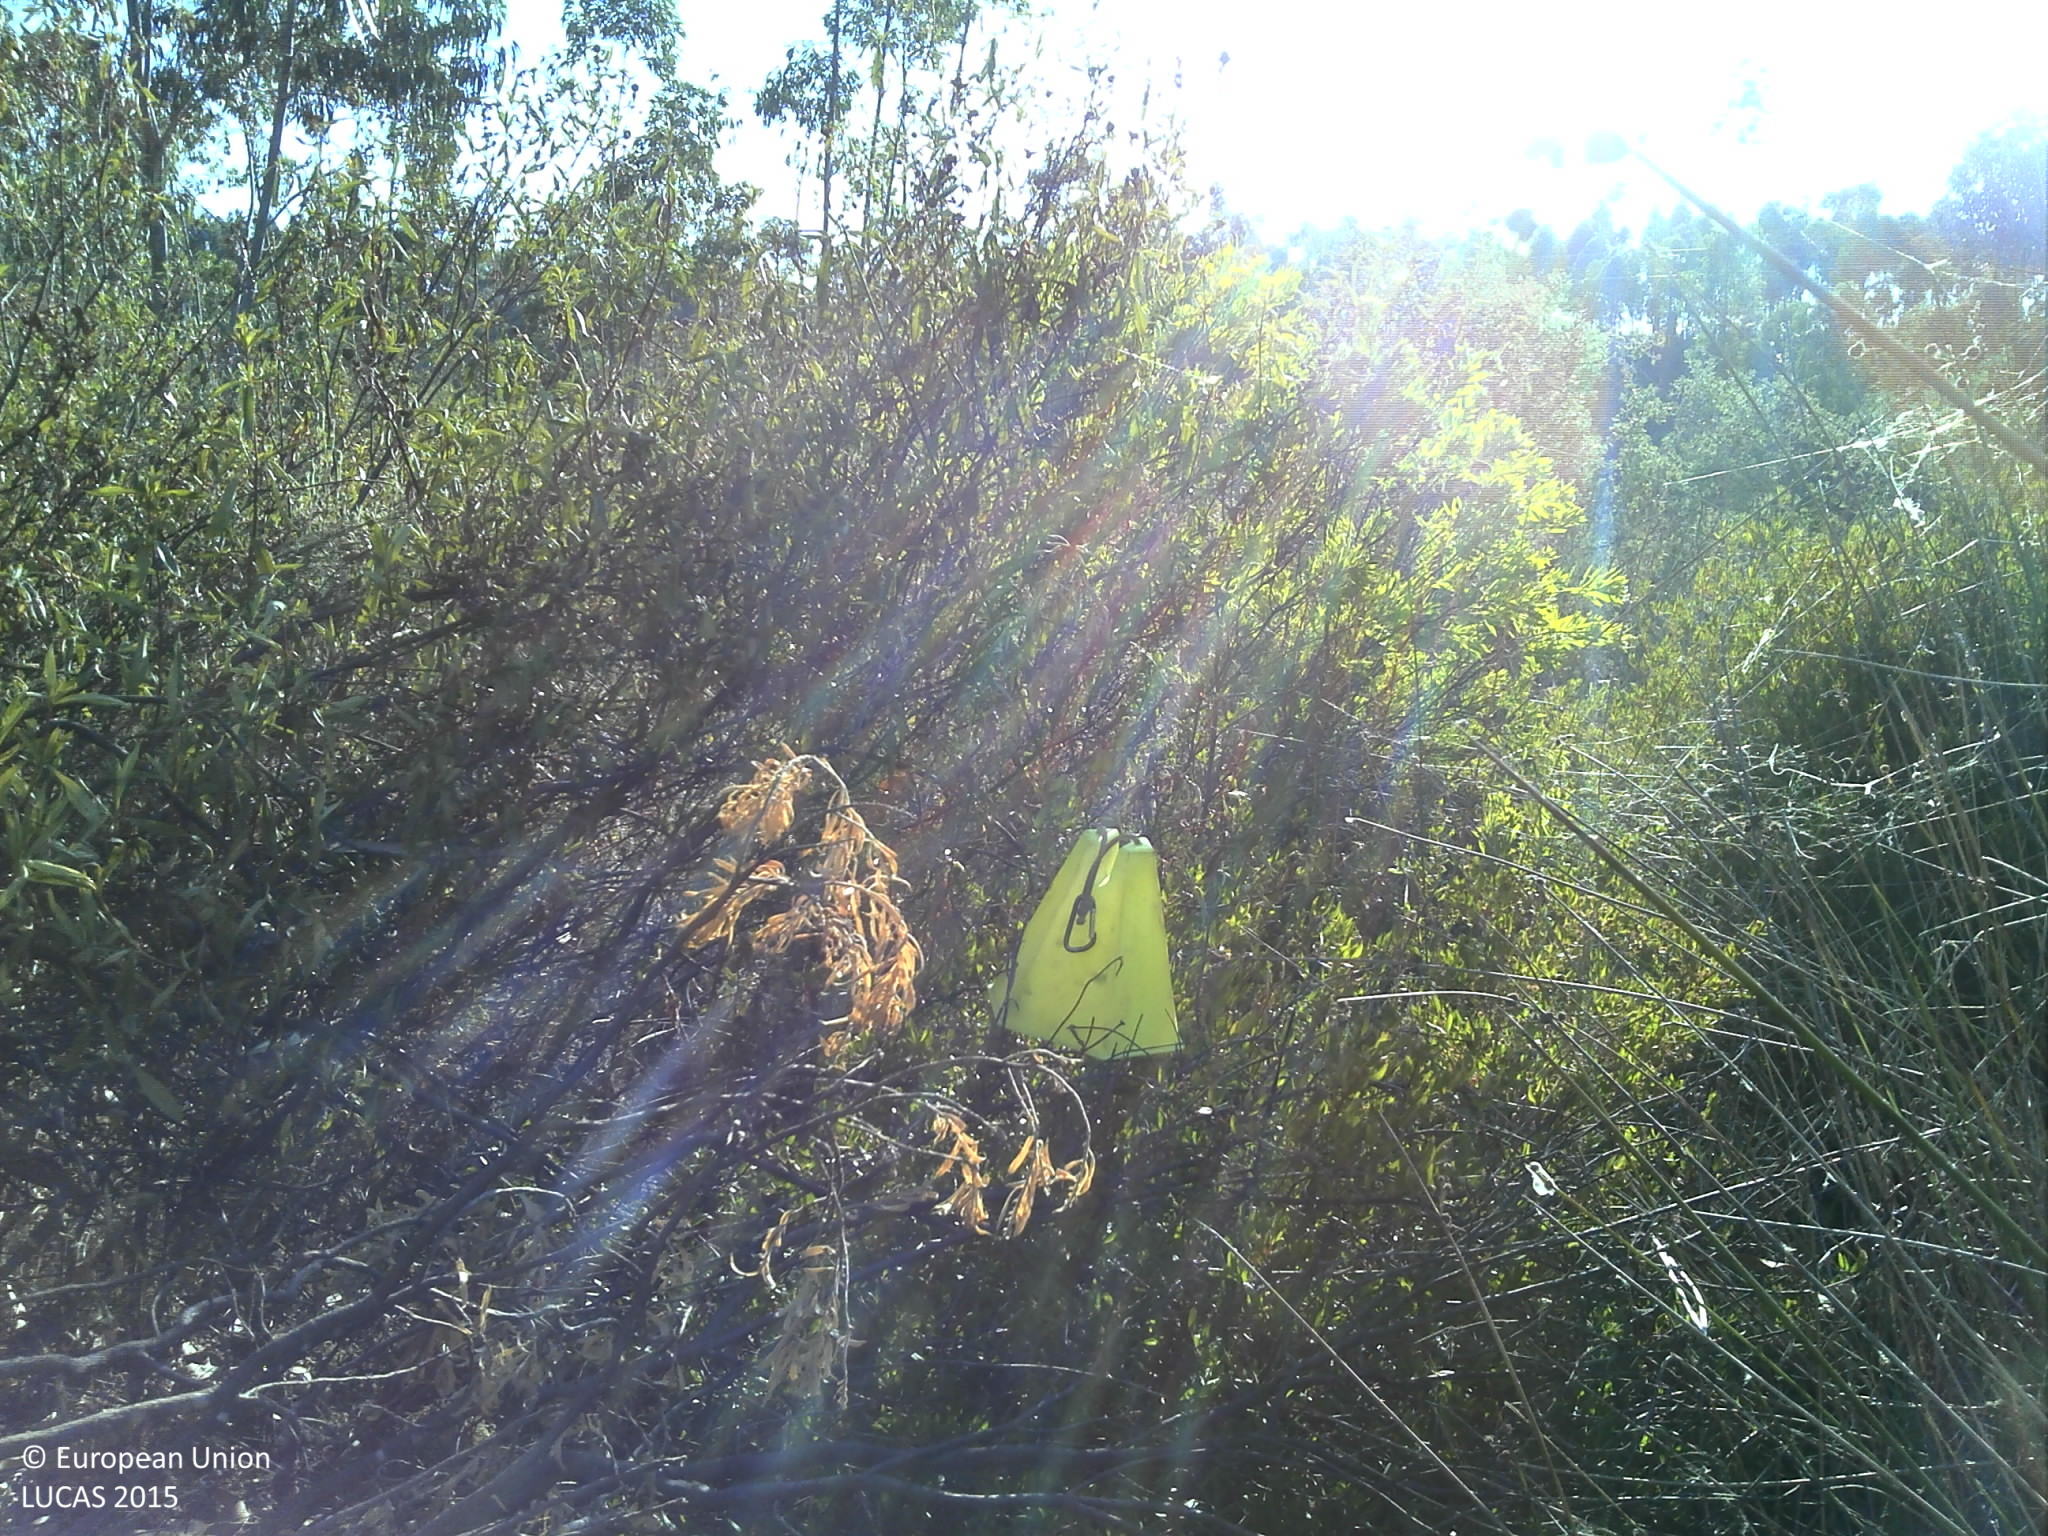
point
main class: Woodland
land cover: Broadleaved woodland
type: exotic forest
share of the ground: 10 - 25 %
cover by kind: shrubs 85 %, broadleaved forest trees 15 %
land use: Forestry
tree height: > 5 m
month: August
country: PT
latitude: 39.6043
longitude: -7.6977
